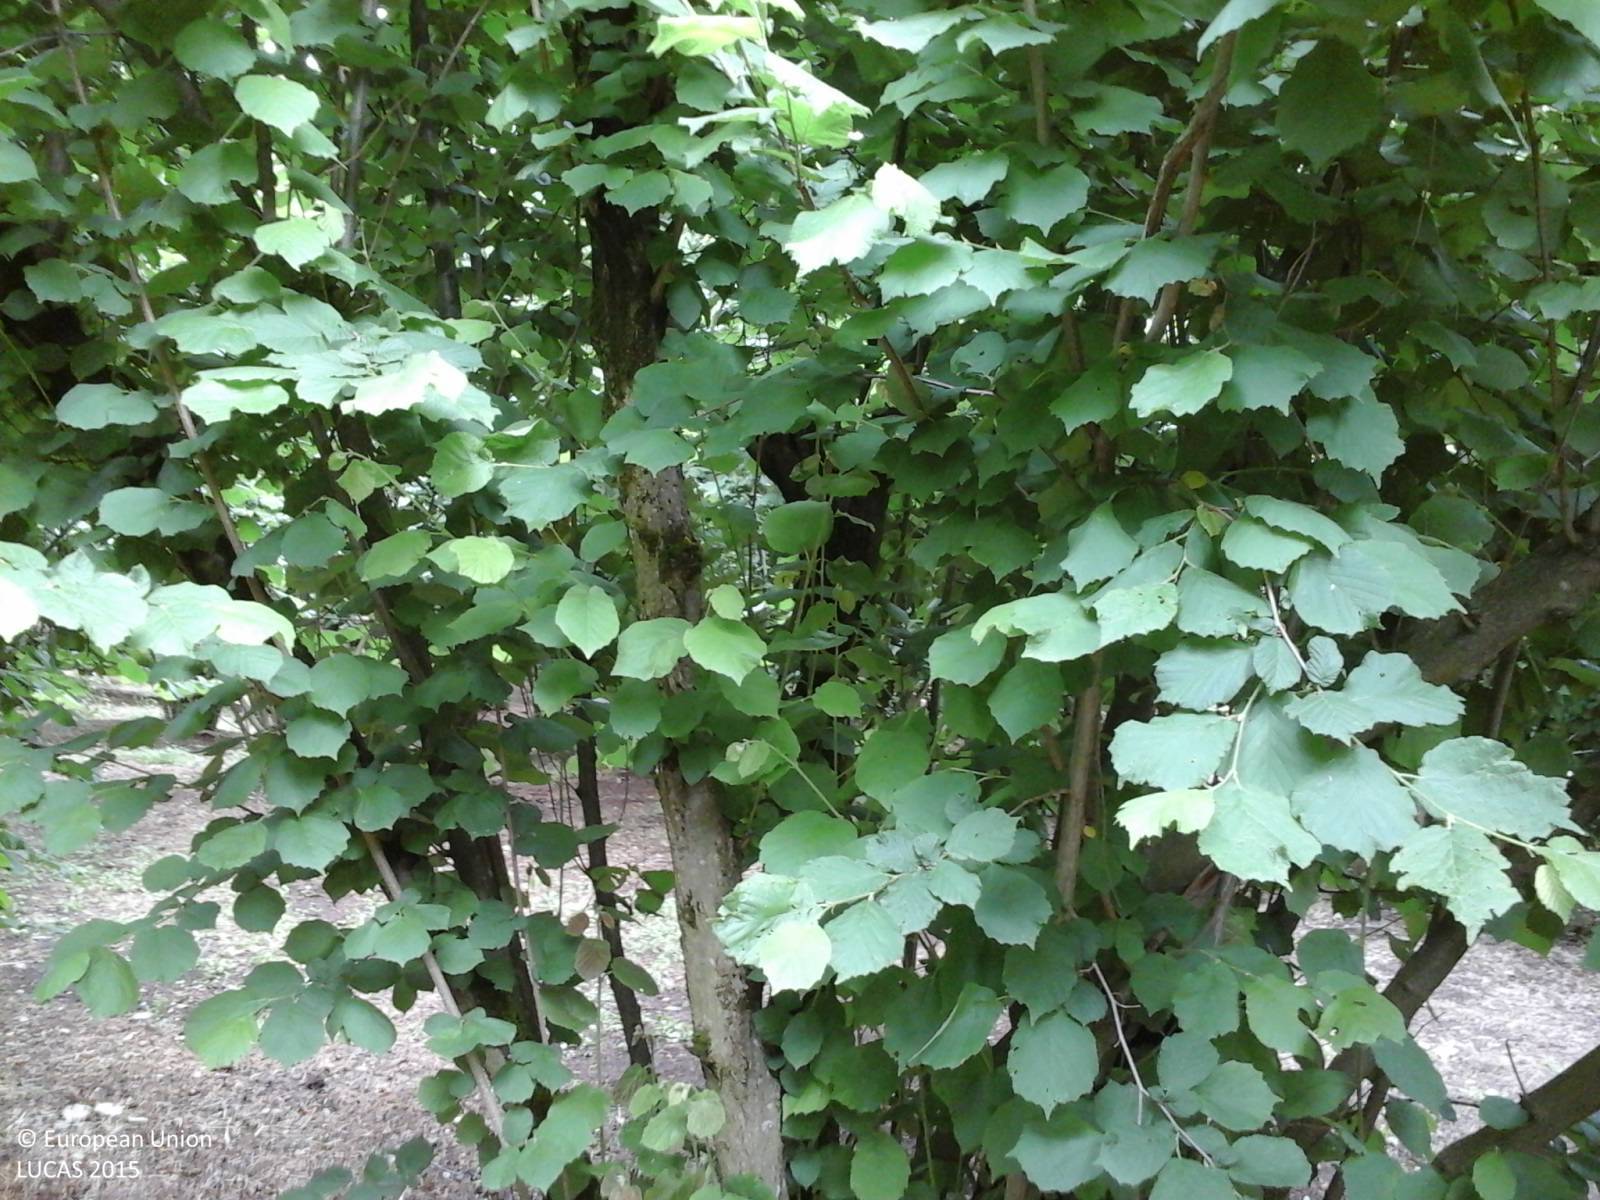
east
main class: Cropland
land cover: Nuts trees
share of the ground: > 75 %
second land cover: Spontaneously vegetated surfaces
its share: 50 - 75 %
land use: Agriculture (excluding fallow land and kitchen gardens)
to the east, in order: Nuts trees; Spontaneously vegetated surfaces; Fences; Olive groves; Artificial constructions in urban areas
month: May
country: IT
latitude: 42.3041
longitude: 12.2364
